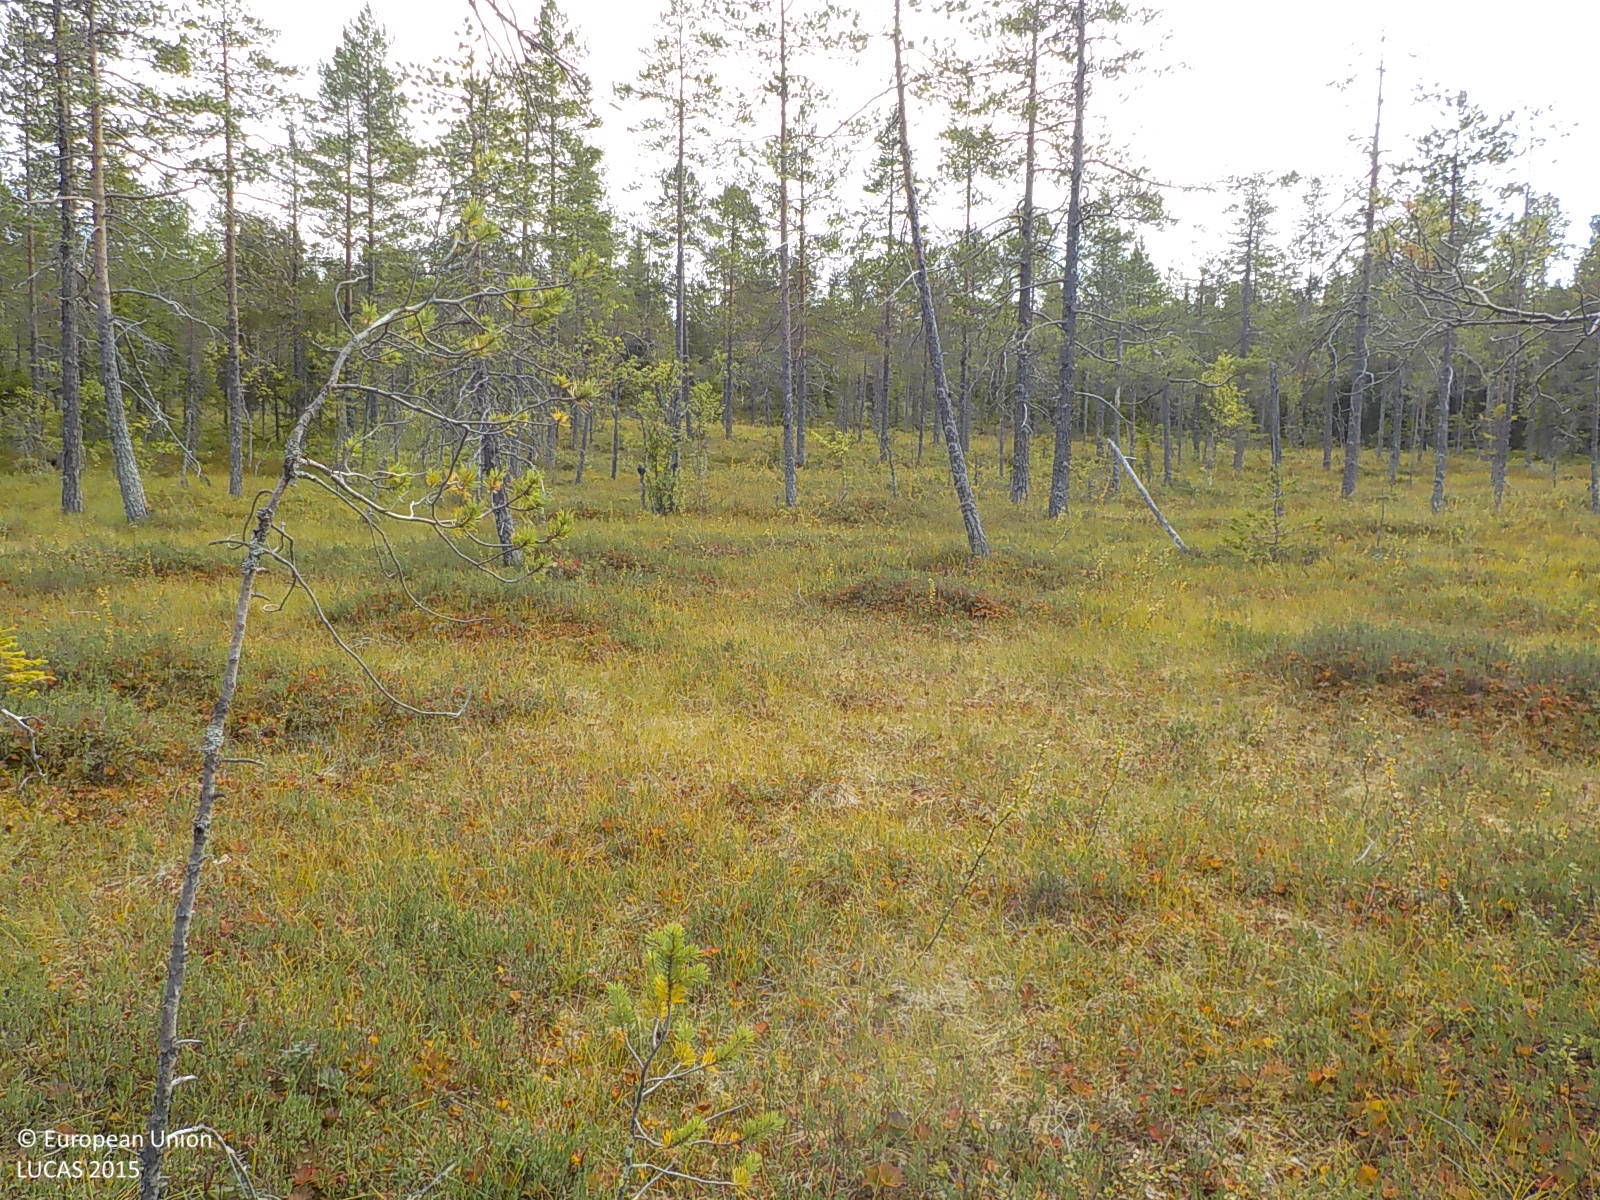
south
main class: Woodland
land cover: Pine dominated coniferous woodland
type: mire and swamp forests
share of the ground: 50 - 75 %
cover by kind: coniferous forest trees 50 %, shrubs 45 %, herbaceous plants 5 %
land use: Semi-natural and natural areas not in use
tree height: > 5 m
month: September
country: SE
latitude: 63.2642
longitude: 17.7661
